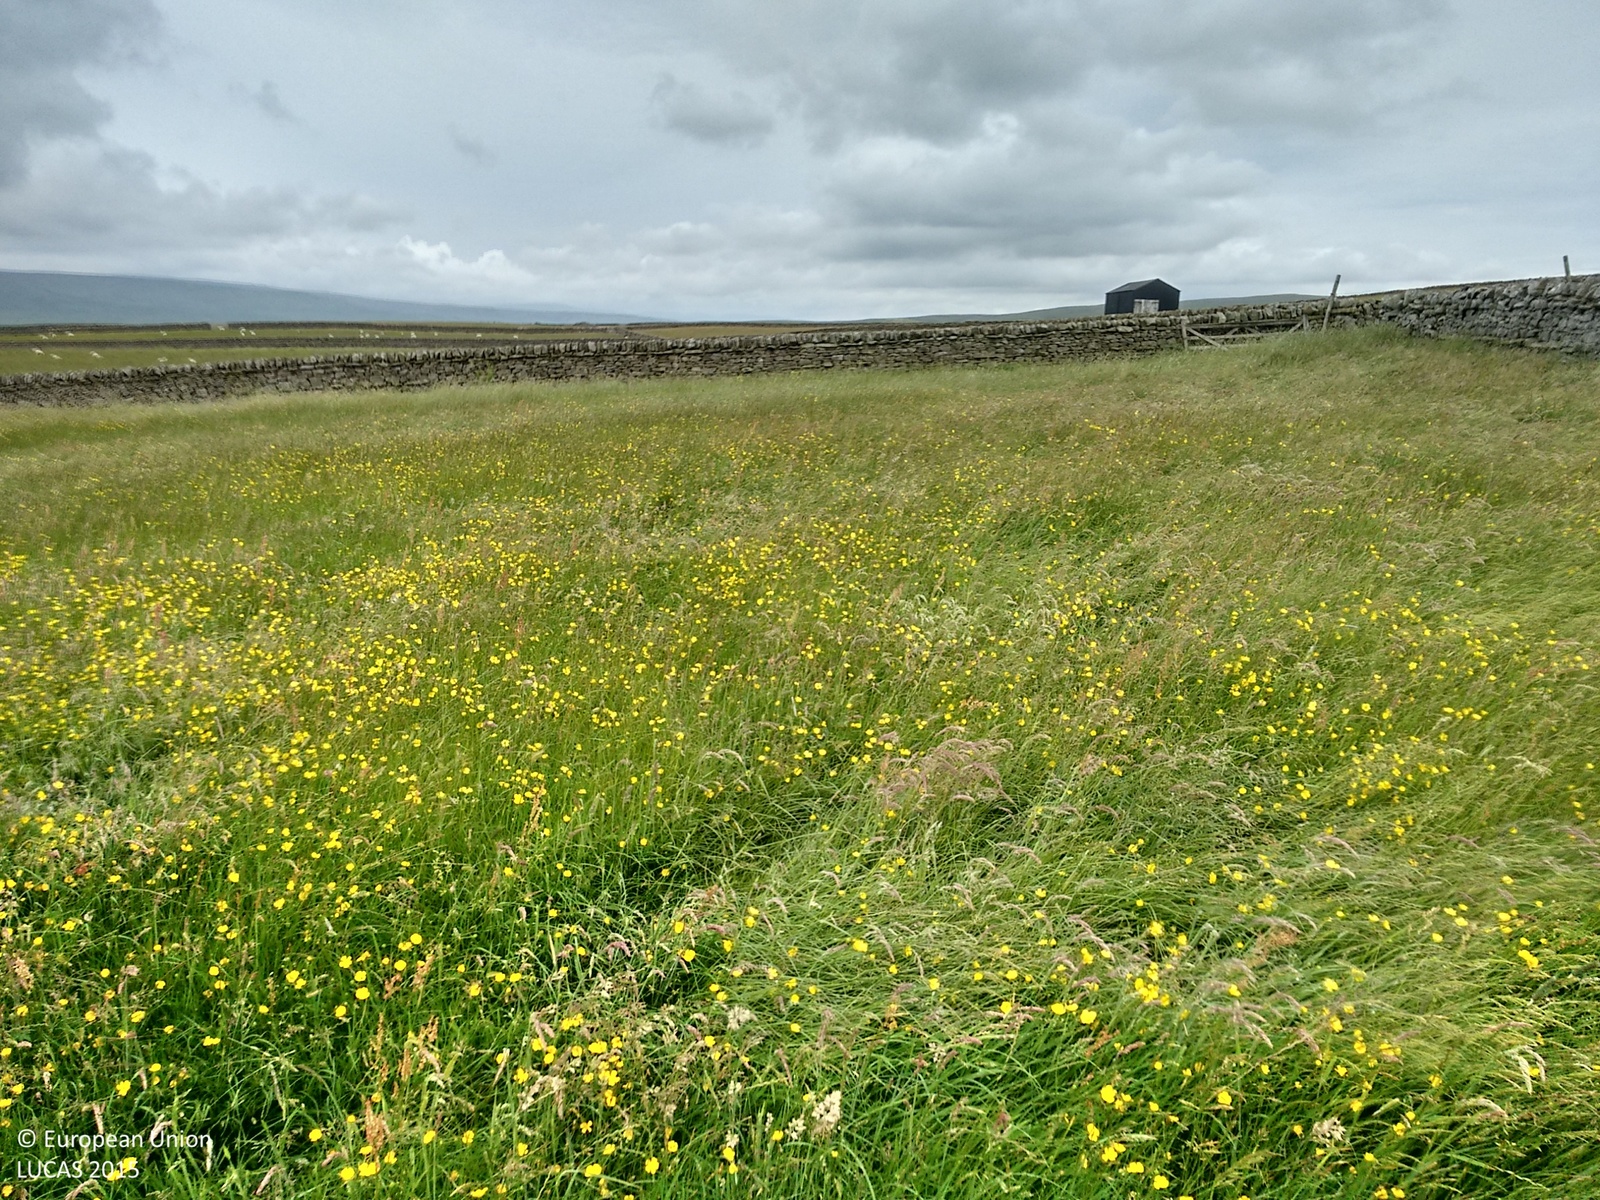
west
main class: Grassland
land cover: Grassland without tree/shrub cover
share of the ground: > 75 %
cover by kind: herbaceous plants 100 %
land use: Agriculture (excluding fallow land and kitchen gardens)
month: July
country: GB
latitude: 54.6335
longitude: -2.0627
